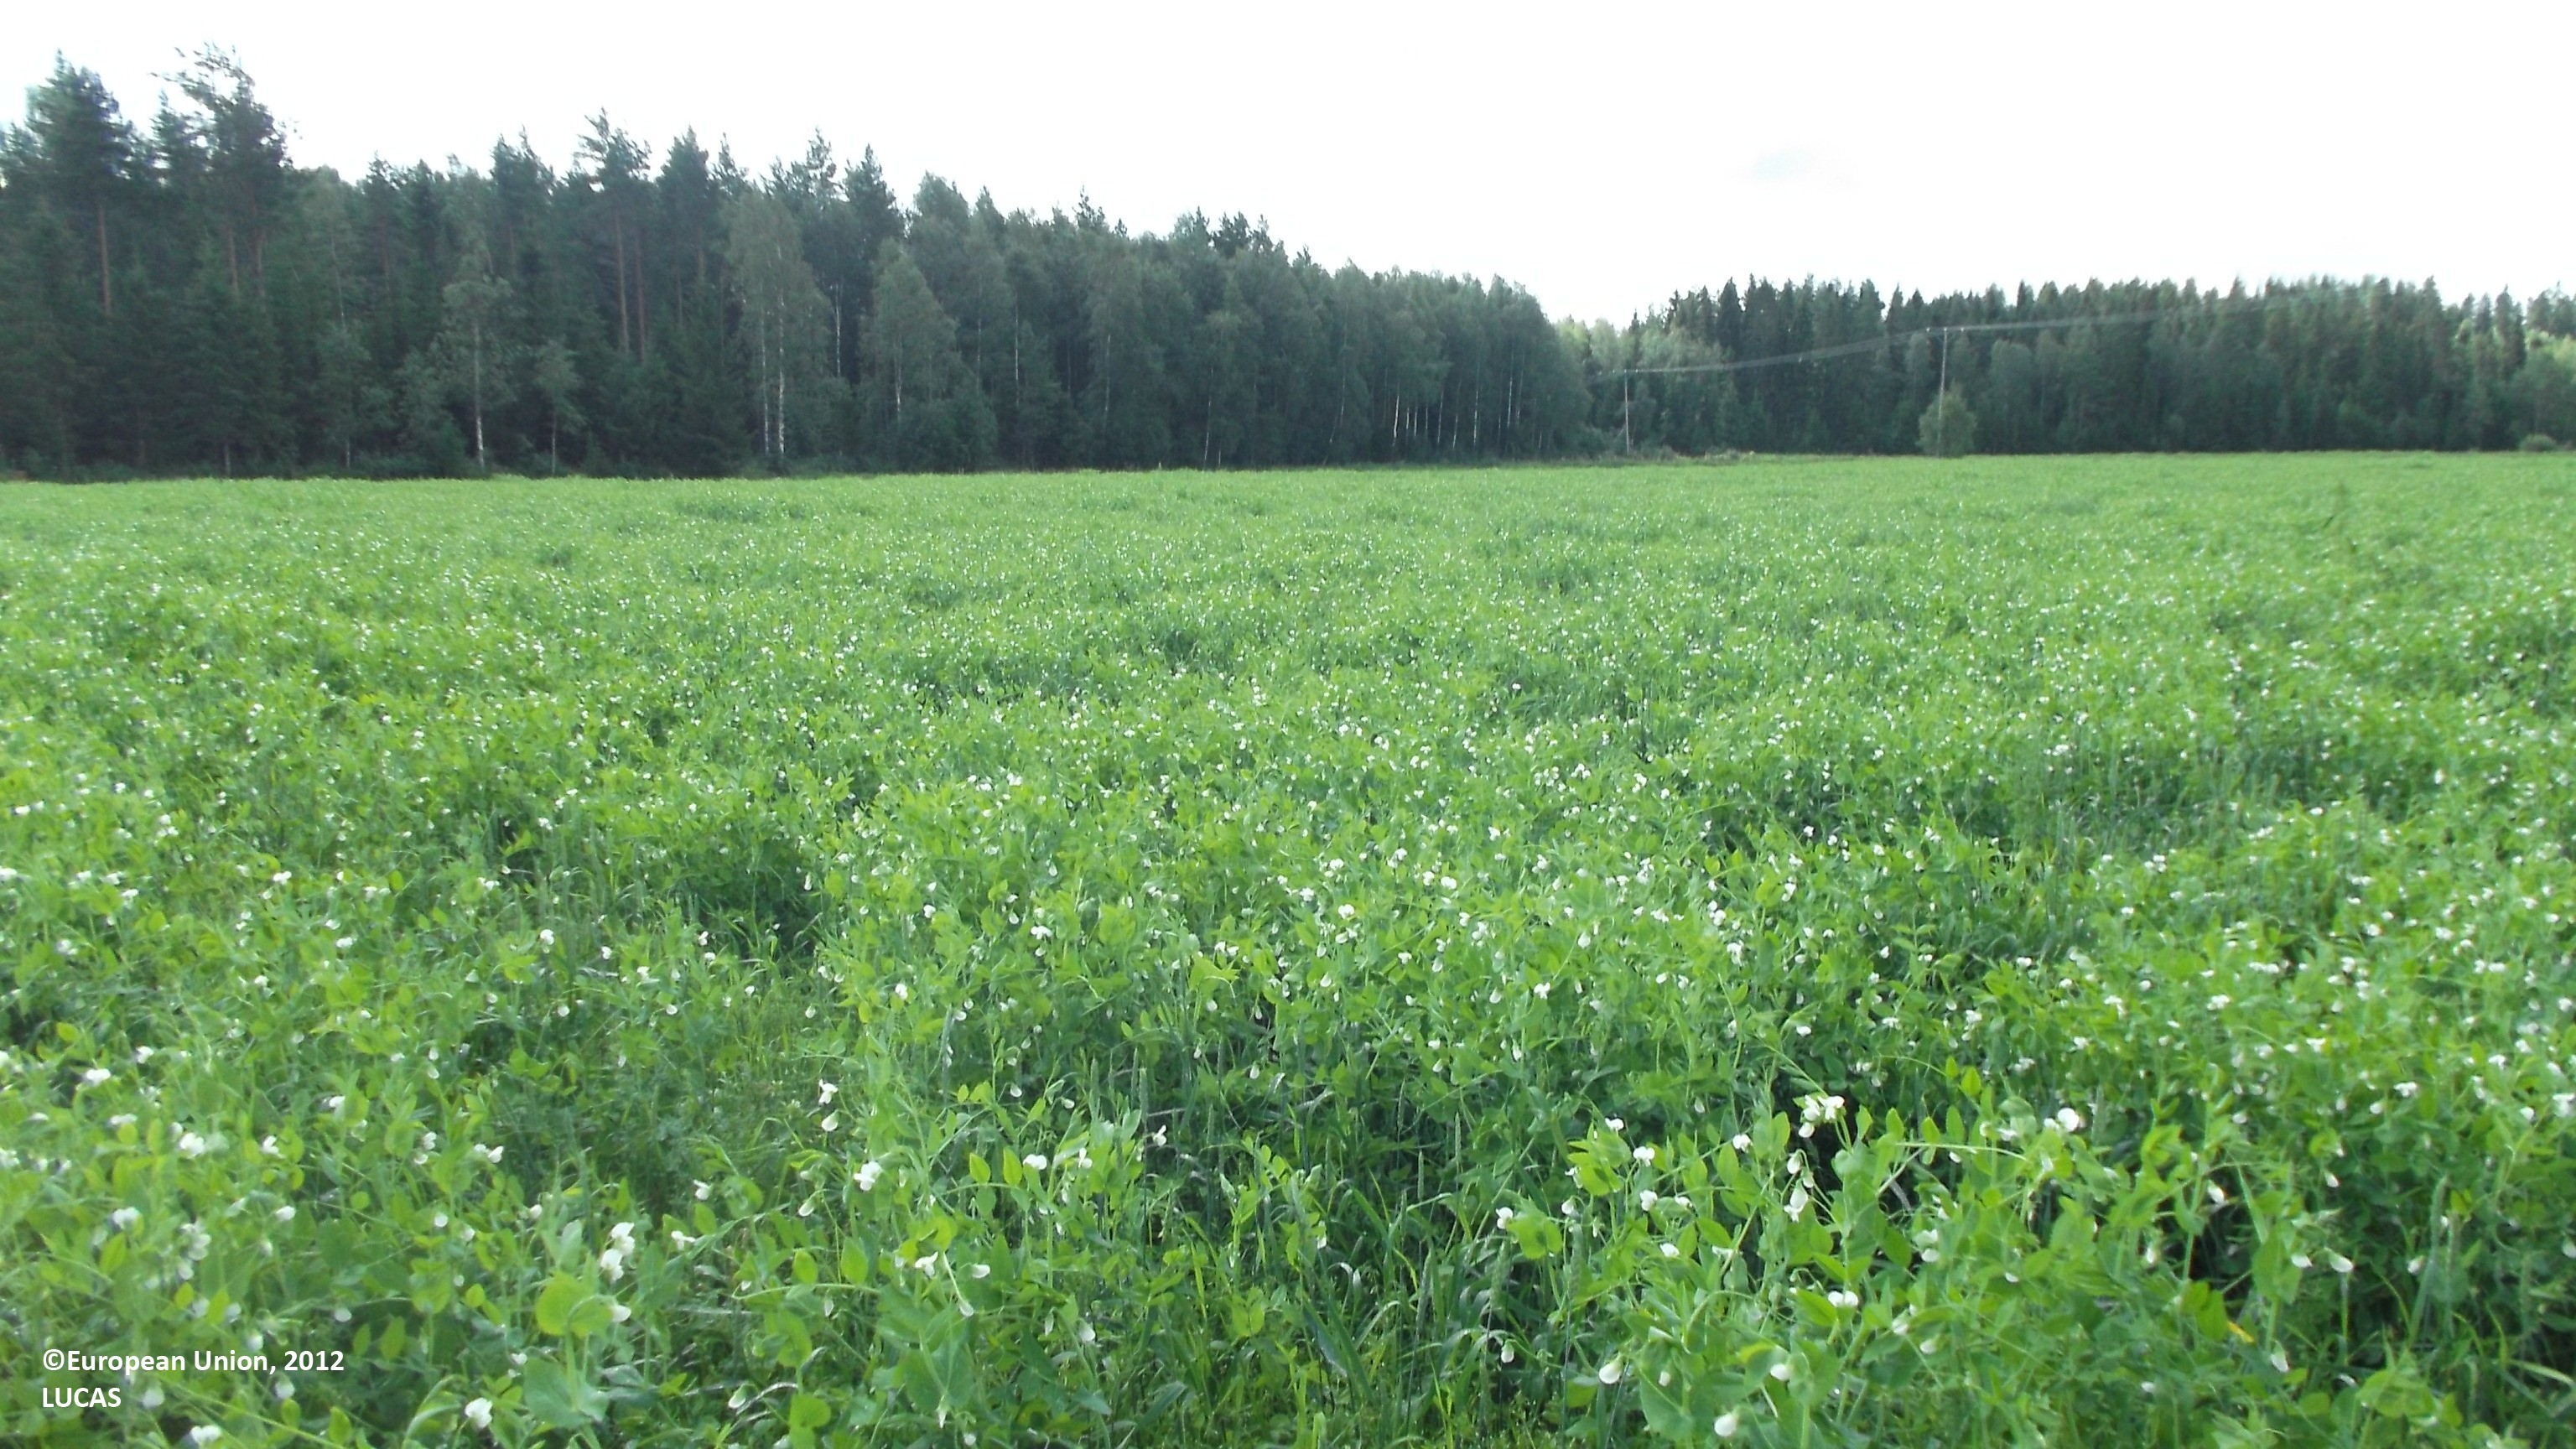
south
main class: Cropland
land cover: Dry pulses
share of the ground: > 75 %
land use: Agriculture (excluding fallow land and kitchen gardens)
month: August
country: FI
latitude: 63.8790
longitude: 23.4323
